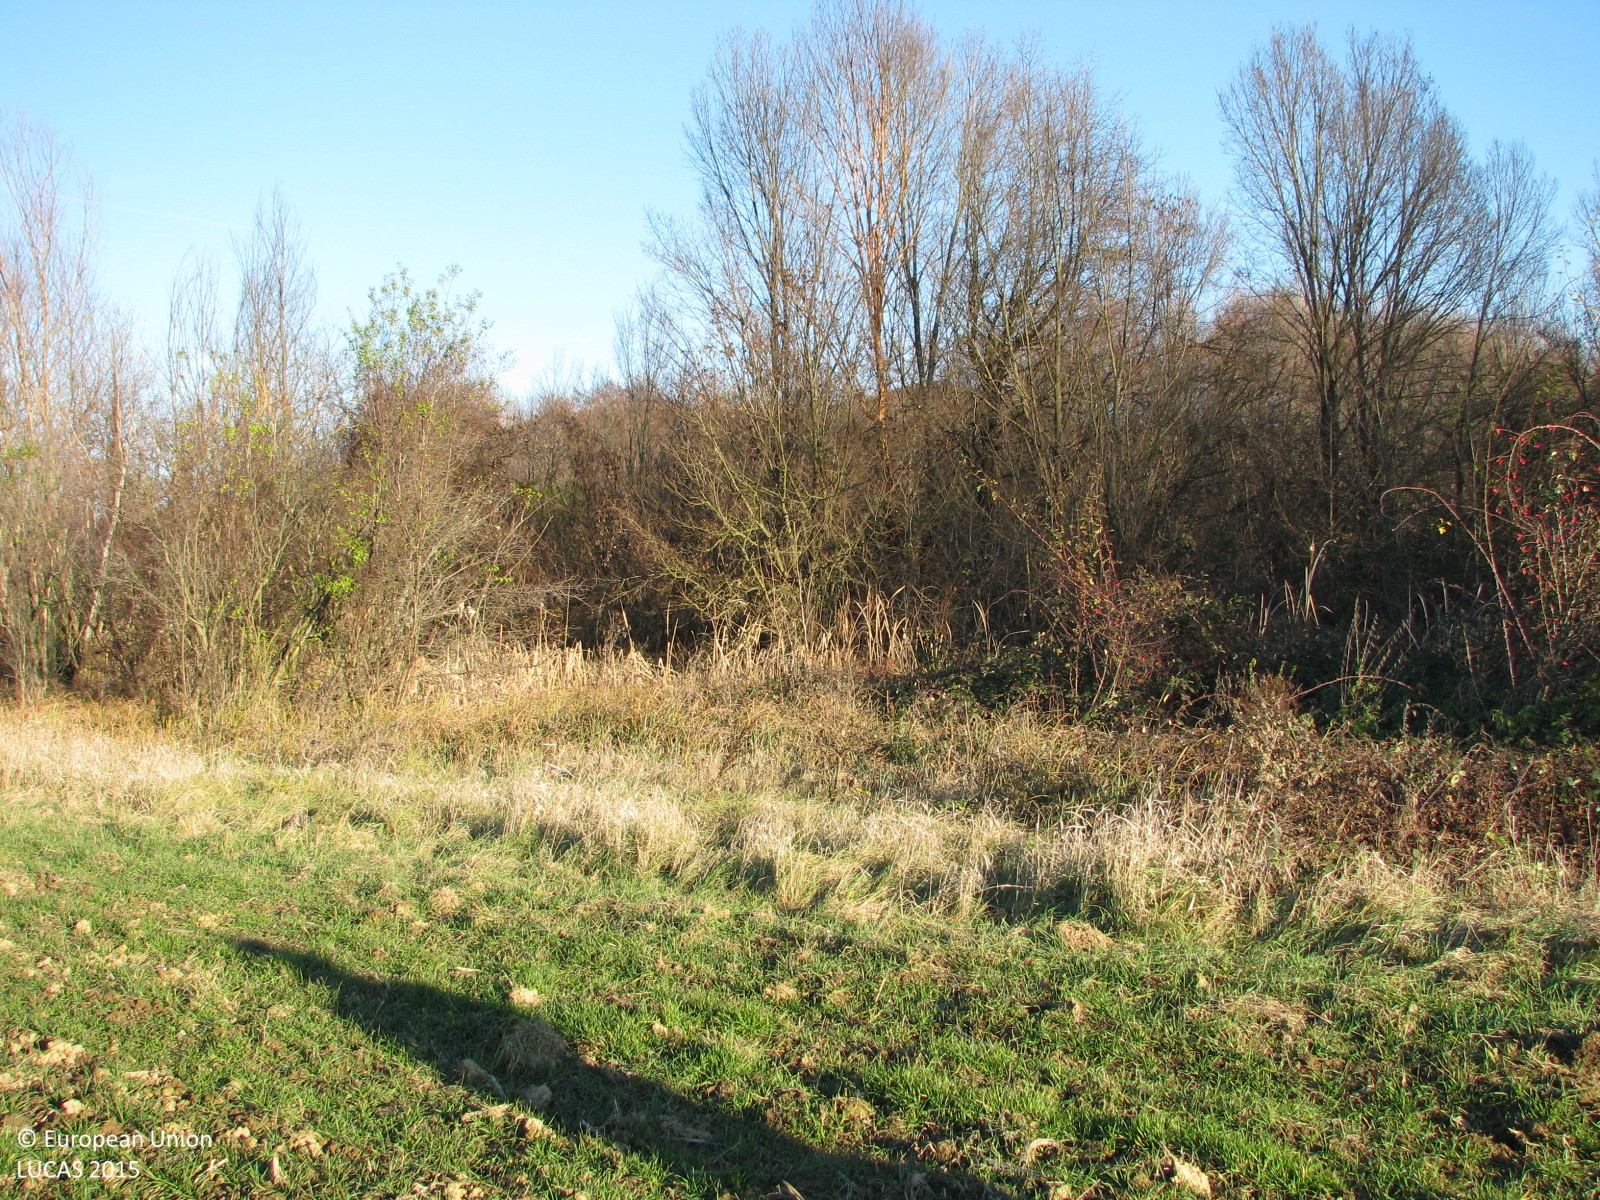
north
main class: Cropland
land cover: Common wheat
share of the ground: > 75 %
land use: Agriculture (excluding fallow land and kitchen gardens)
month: December
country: BG
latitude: 42.4888
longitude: 24.8392
